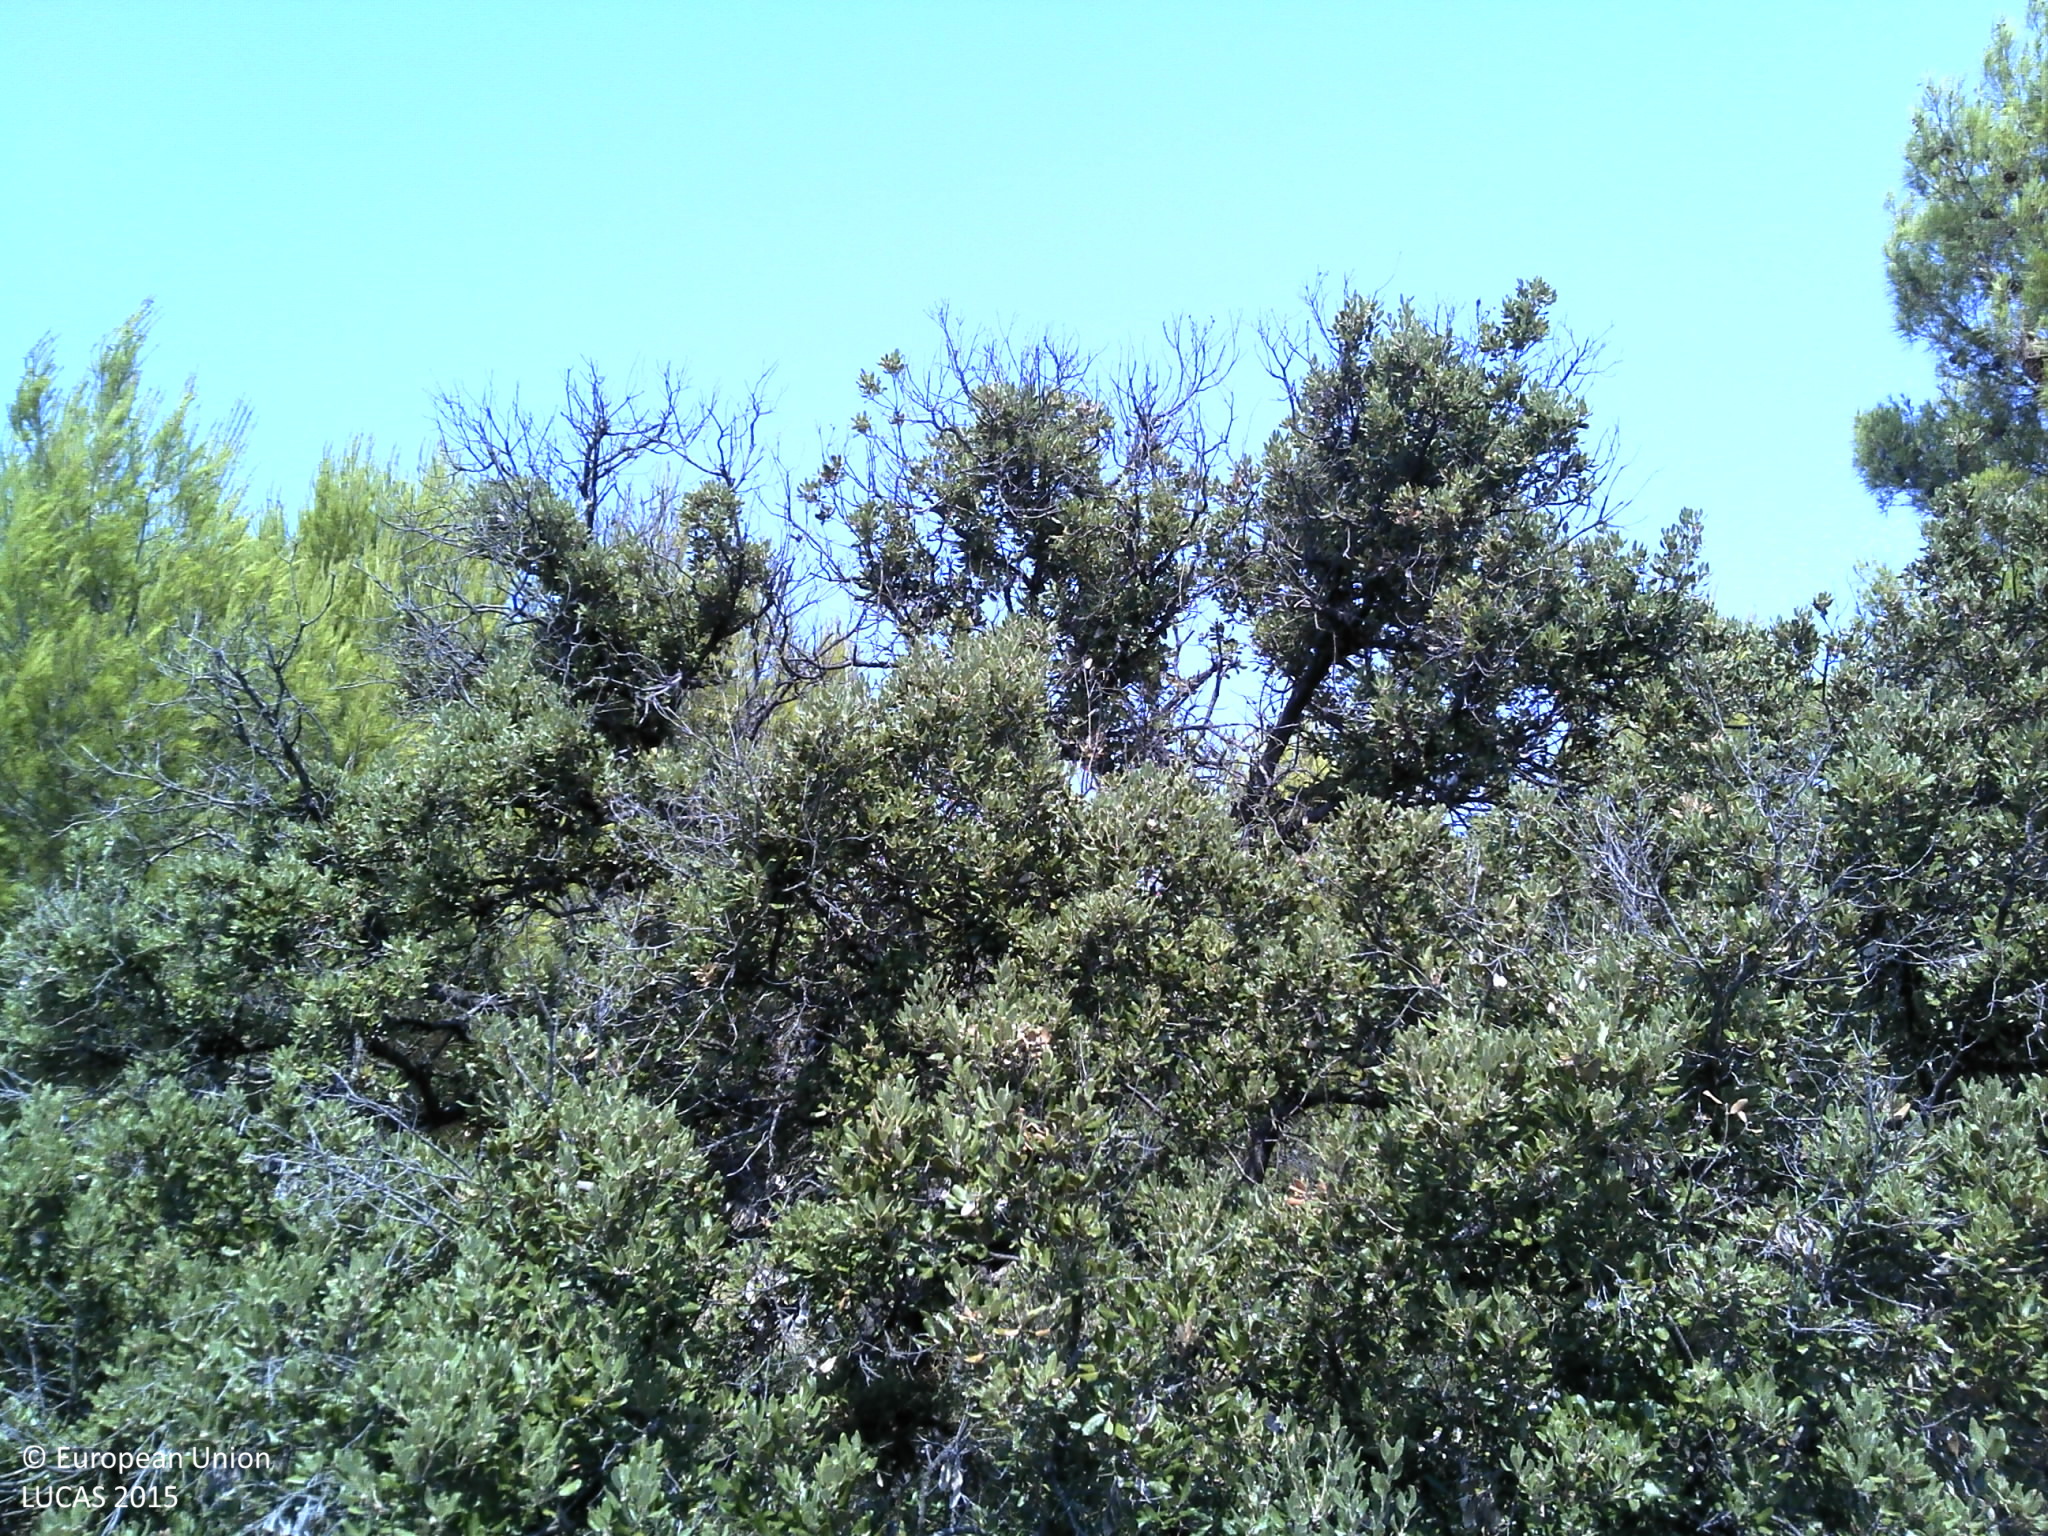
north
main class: Woodland
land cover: Pine dominated coniferous woodland
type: coniferous forest of the mediterranean region
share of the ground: 50 - 75 %
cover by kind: coniferous forest trees 50 %, shrubs 20 %, herbaceous plants 20 %, unconsolidated bare surface 10 %
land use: Semi-natural and natural areas not in use
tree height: > 5 m
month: August
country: HR
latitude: 44.3002
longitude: 15.0438
